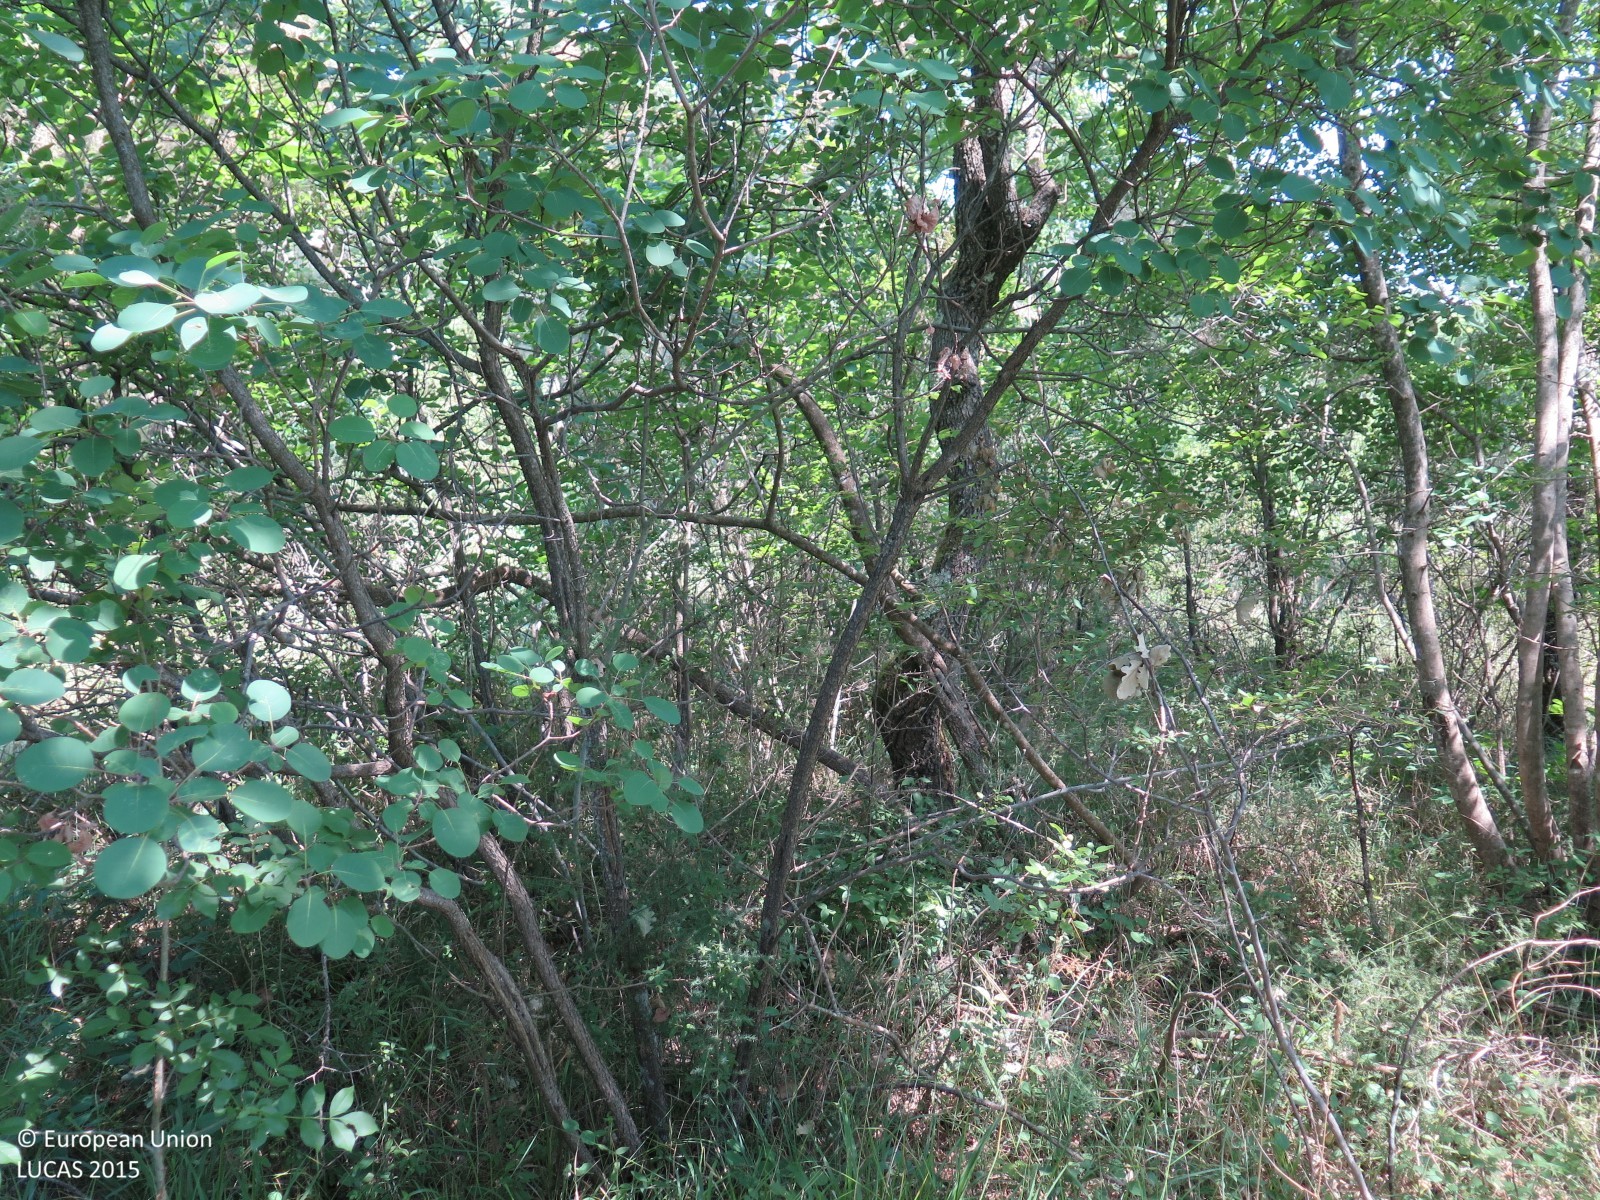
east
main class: Woodland
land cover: Broadleaved woodland
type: mesophytic deciduous forest
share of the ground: > 75 %
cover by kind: broadleaved forest trees 90 %, shrubs 5 %, herbaceous plants 5 %
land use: Semi-natural and natural areas not in use
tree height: > 5 m
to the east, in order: Broadleaved woodland; Tracks; Shrubland with sparse tree cover; Broadleaved woodland; Grassland without tree/shrub cover; Tracks; Dry stone walls; Temporary grasslands
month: July
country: HR
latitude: 45.4435
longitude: 13.5878
